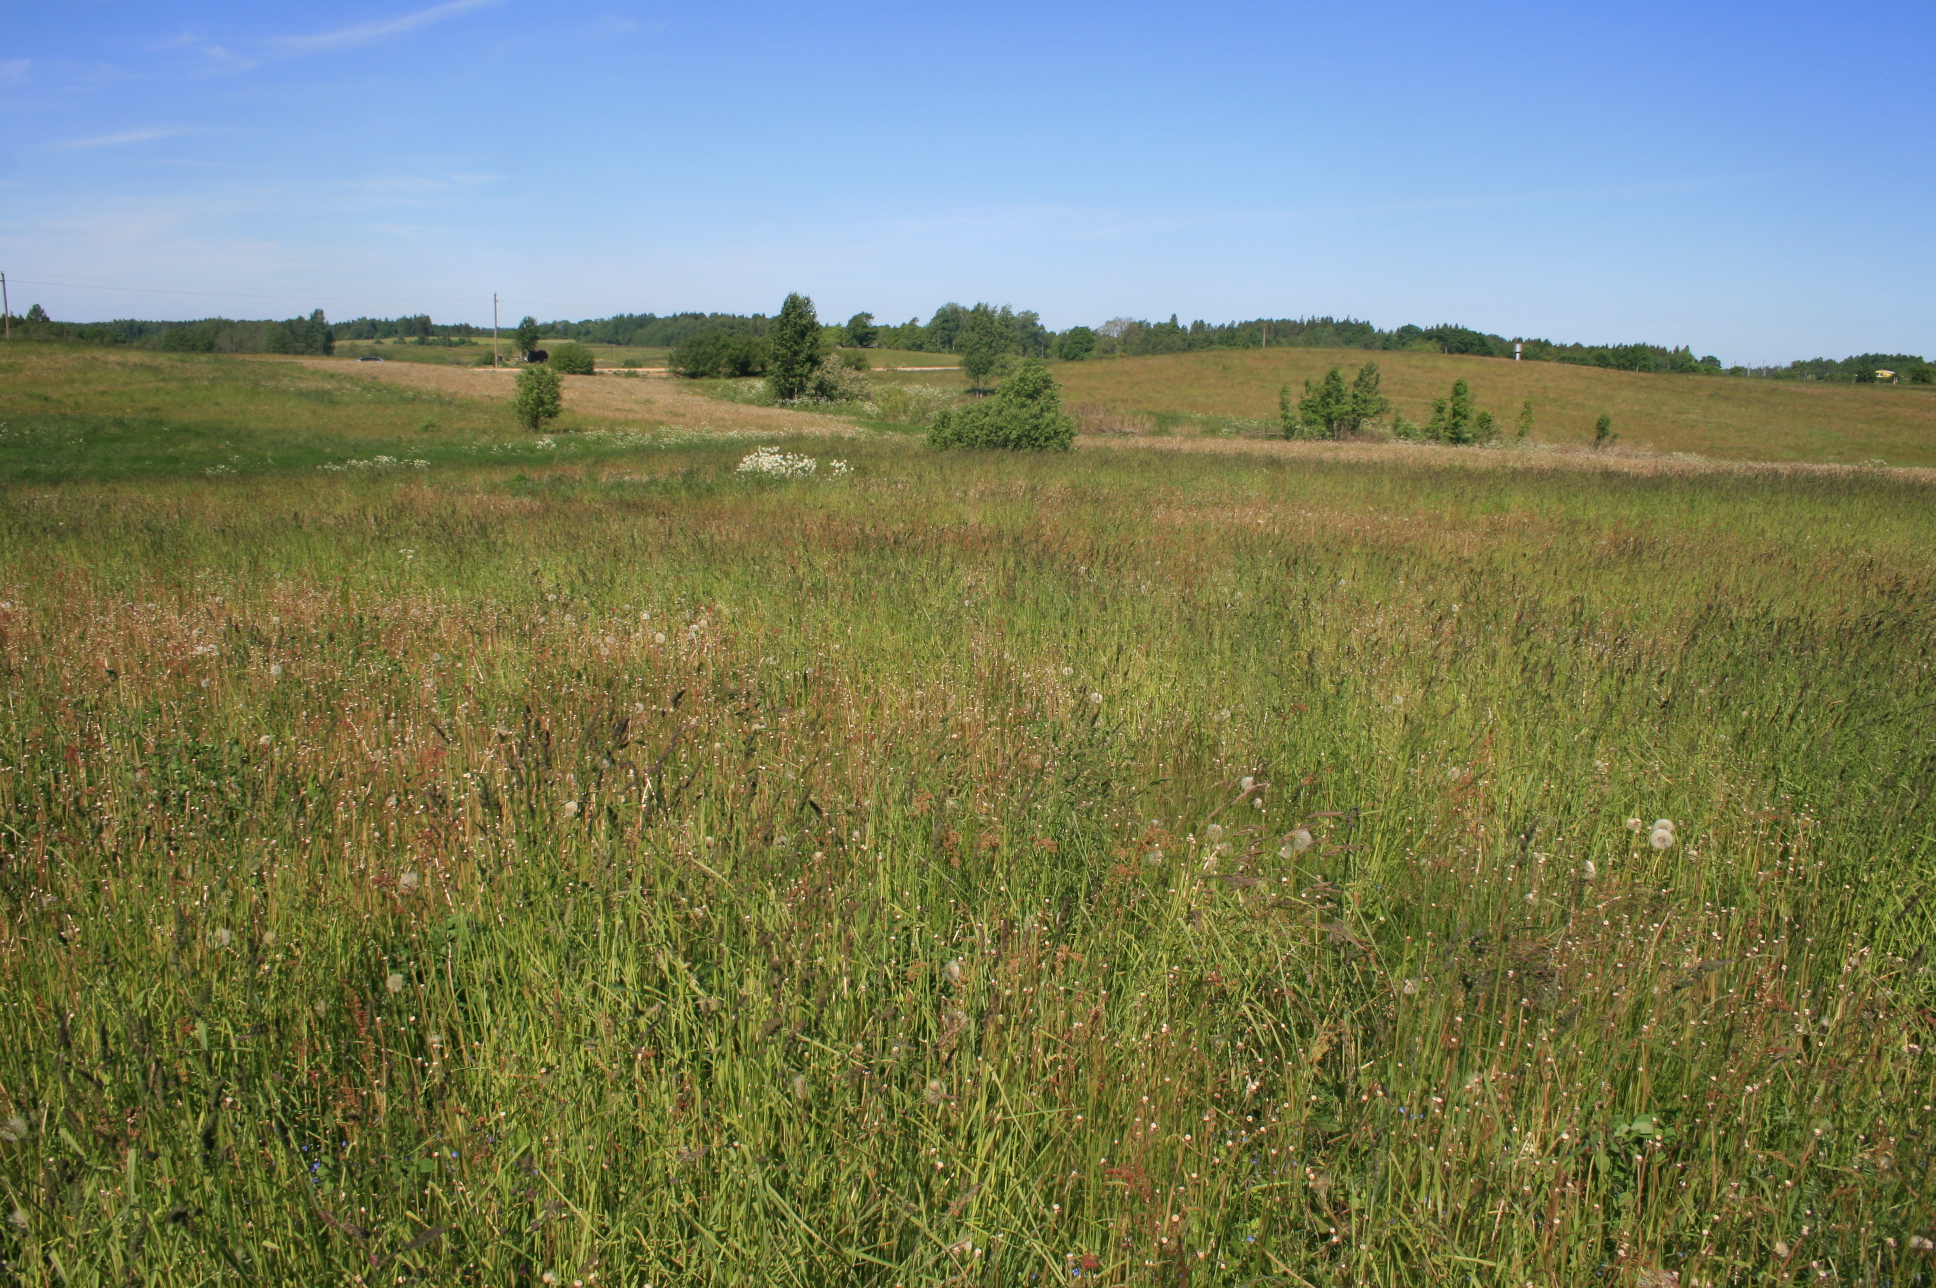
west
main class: Grassland
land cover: Grassland without tree/shrub cover
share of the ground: > 75 %
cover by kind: herbaceous plants 100 %
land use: Agriculture (excluding fallow land and kitchen gardens)
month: June
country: LT
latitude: 55.9304
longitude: 22.2032
